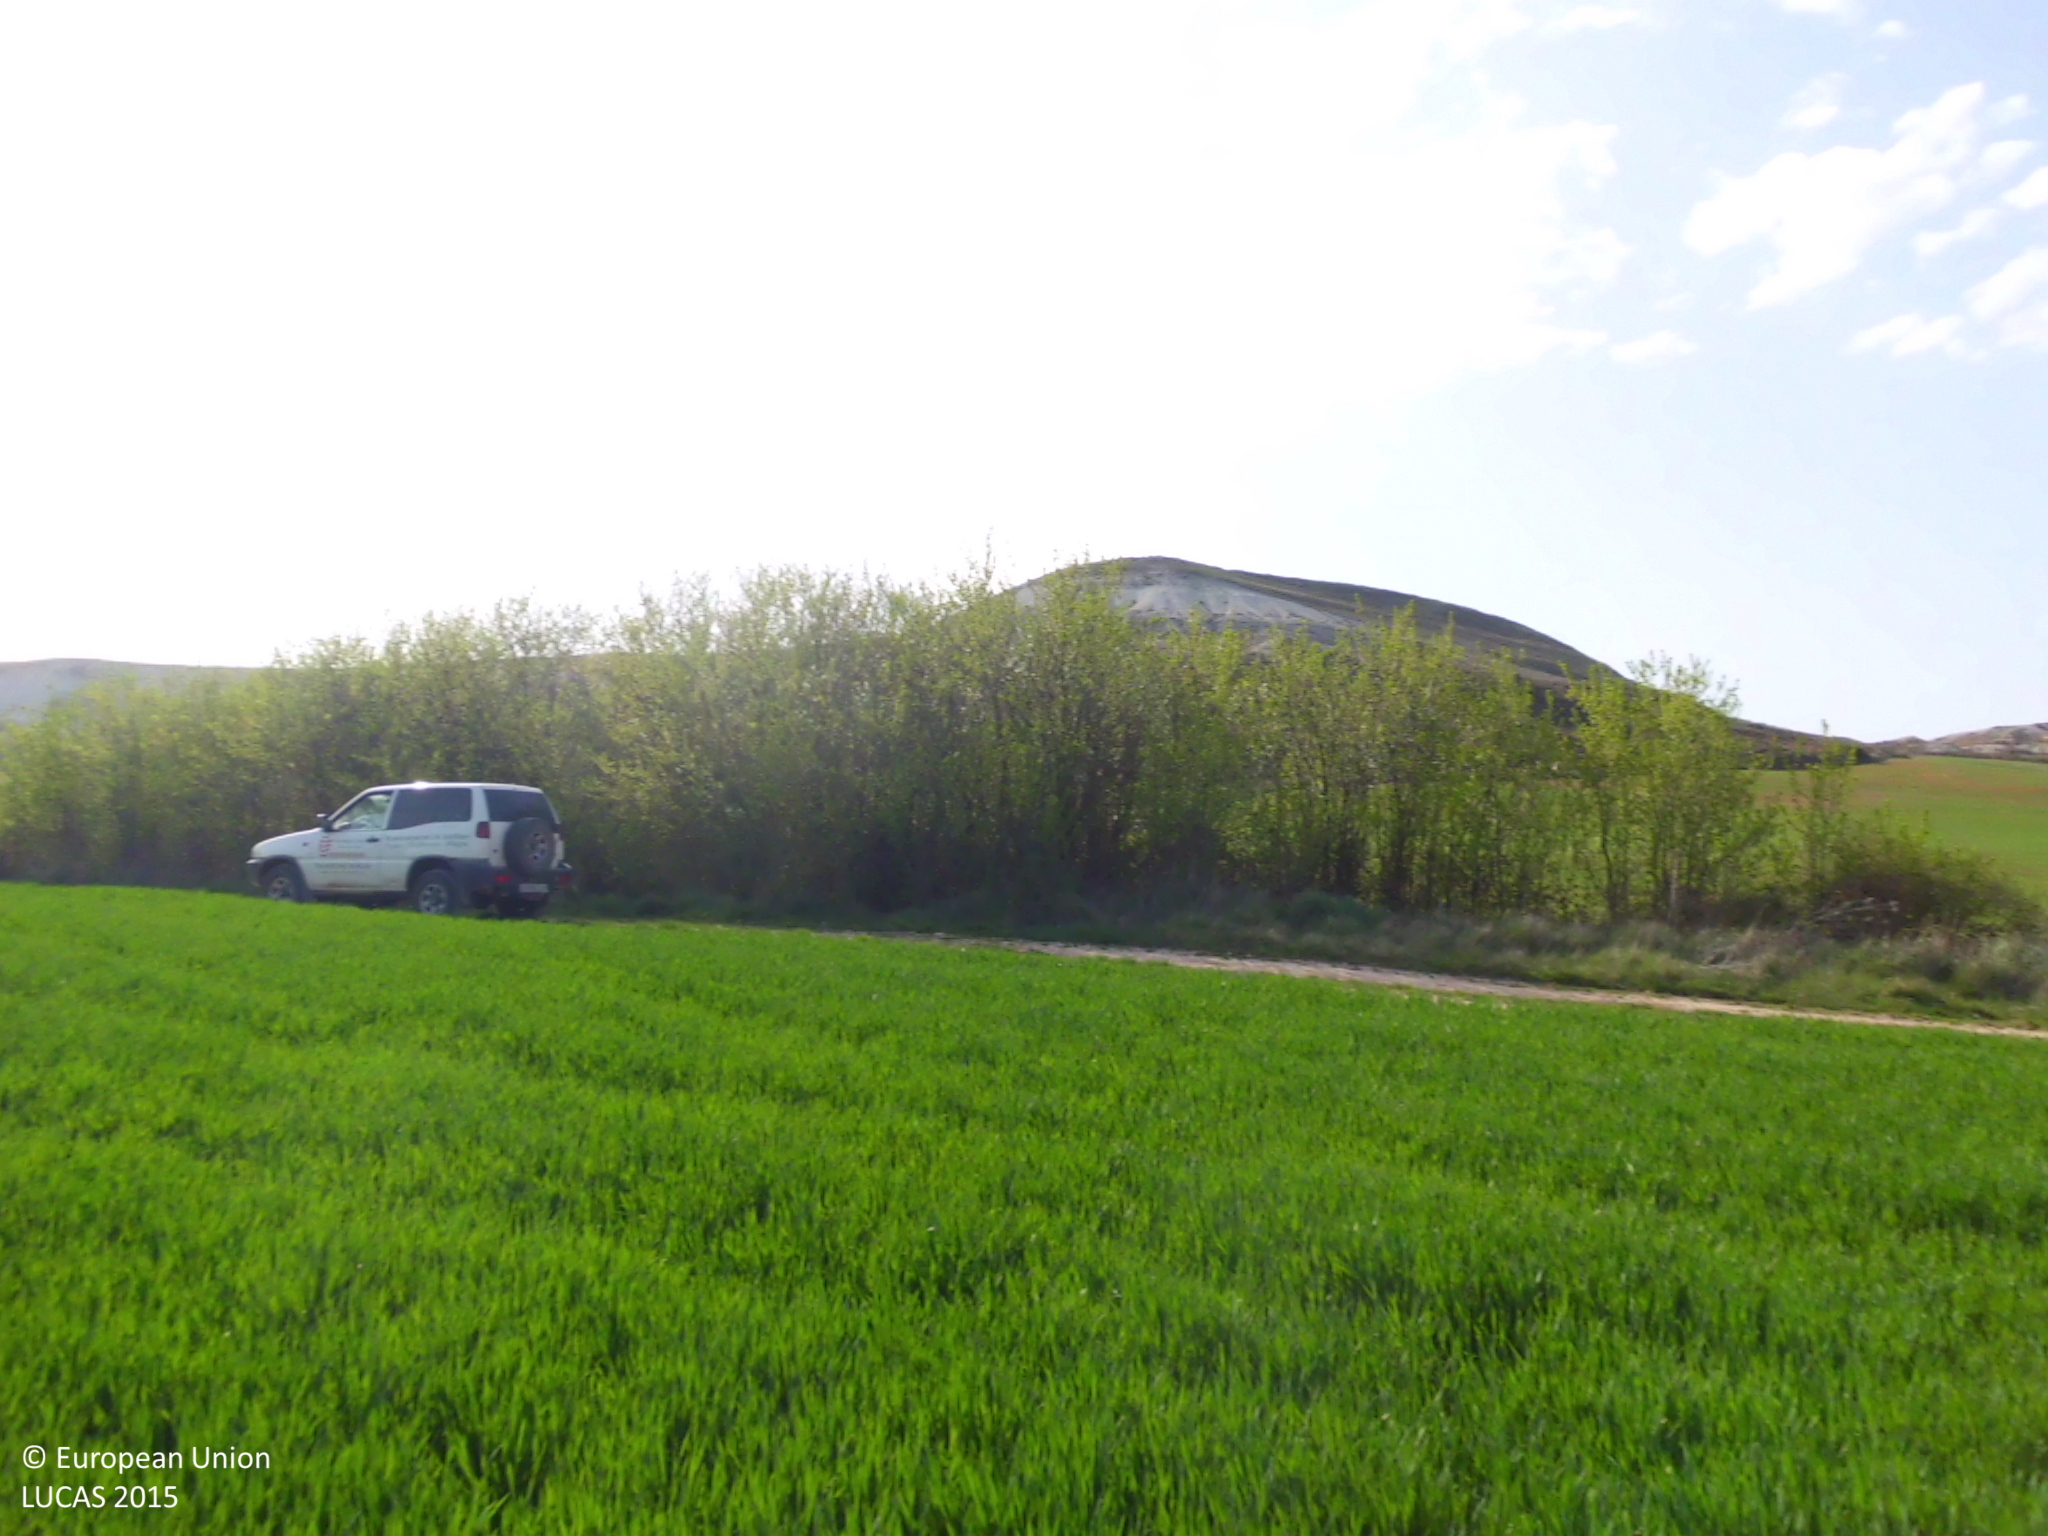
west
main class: Cropland
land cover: Common wheat
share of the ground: > 75 %
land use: Agriculture (excluding fallow land and kitchen gardens)
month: April
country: ES
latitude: 42.5752
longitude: -3.4485
